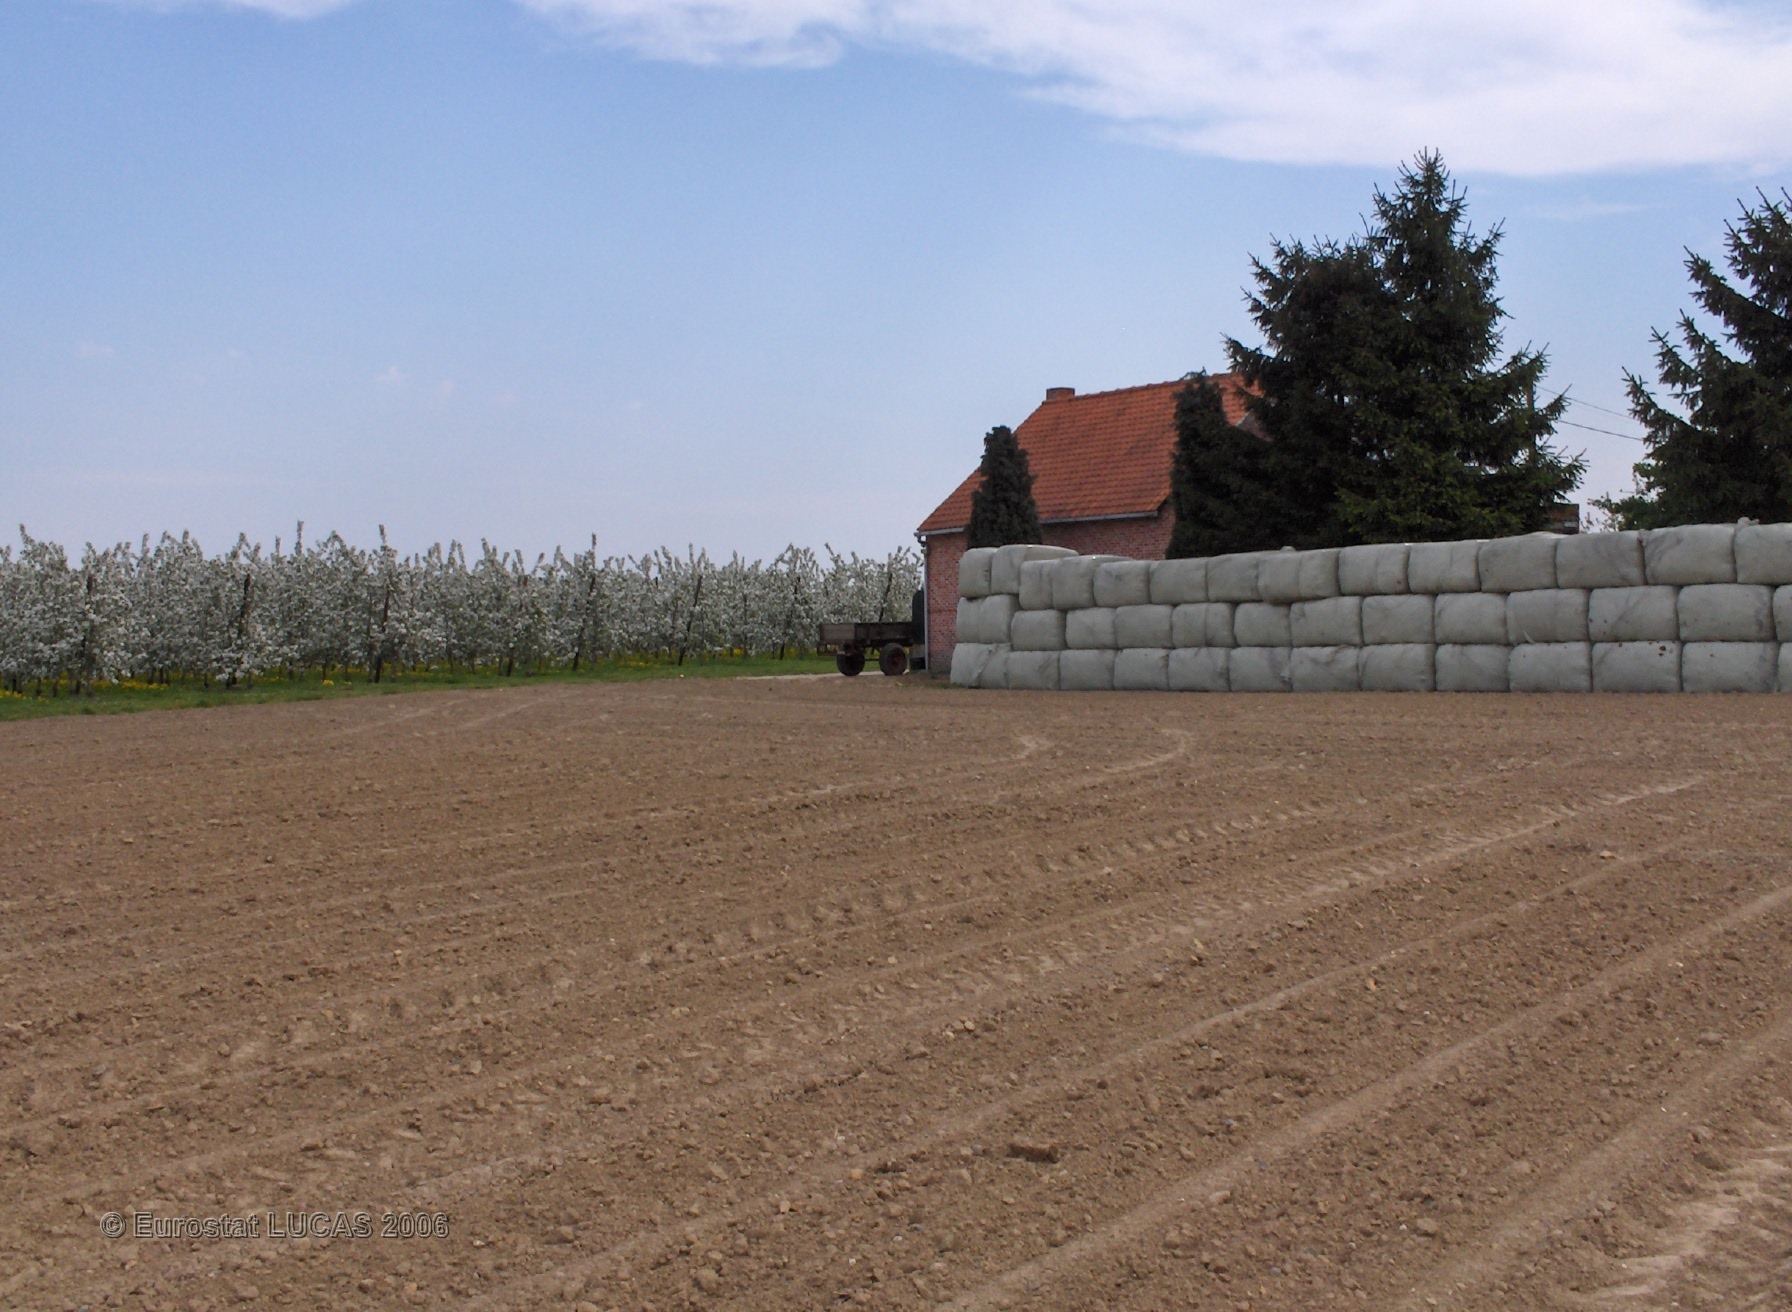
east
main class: Cropland
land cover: Maize
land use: Agriculture (excluding fallow land and kitchen gardens)
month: May
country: BE
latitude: 50.9120
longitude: 5.2045
